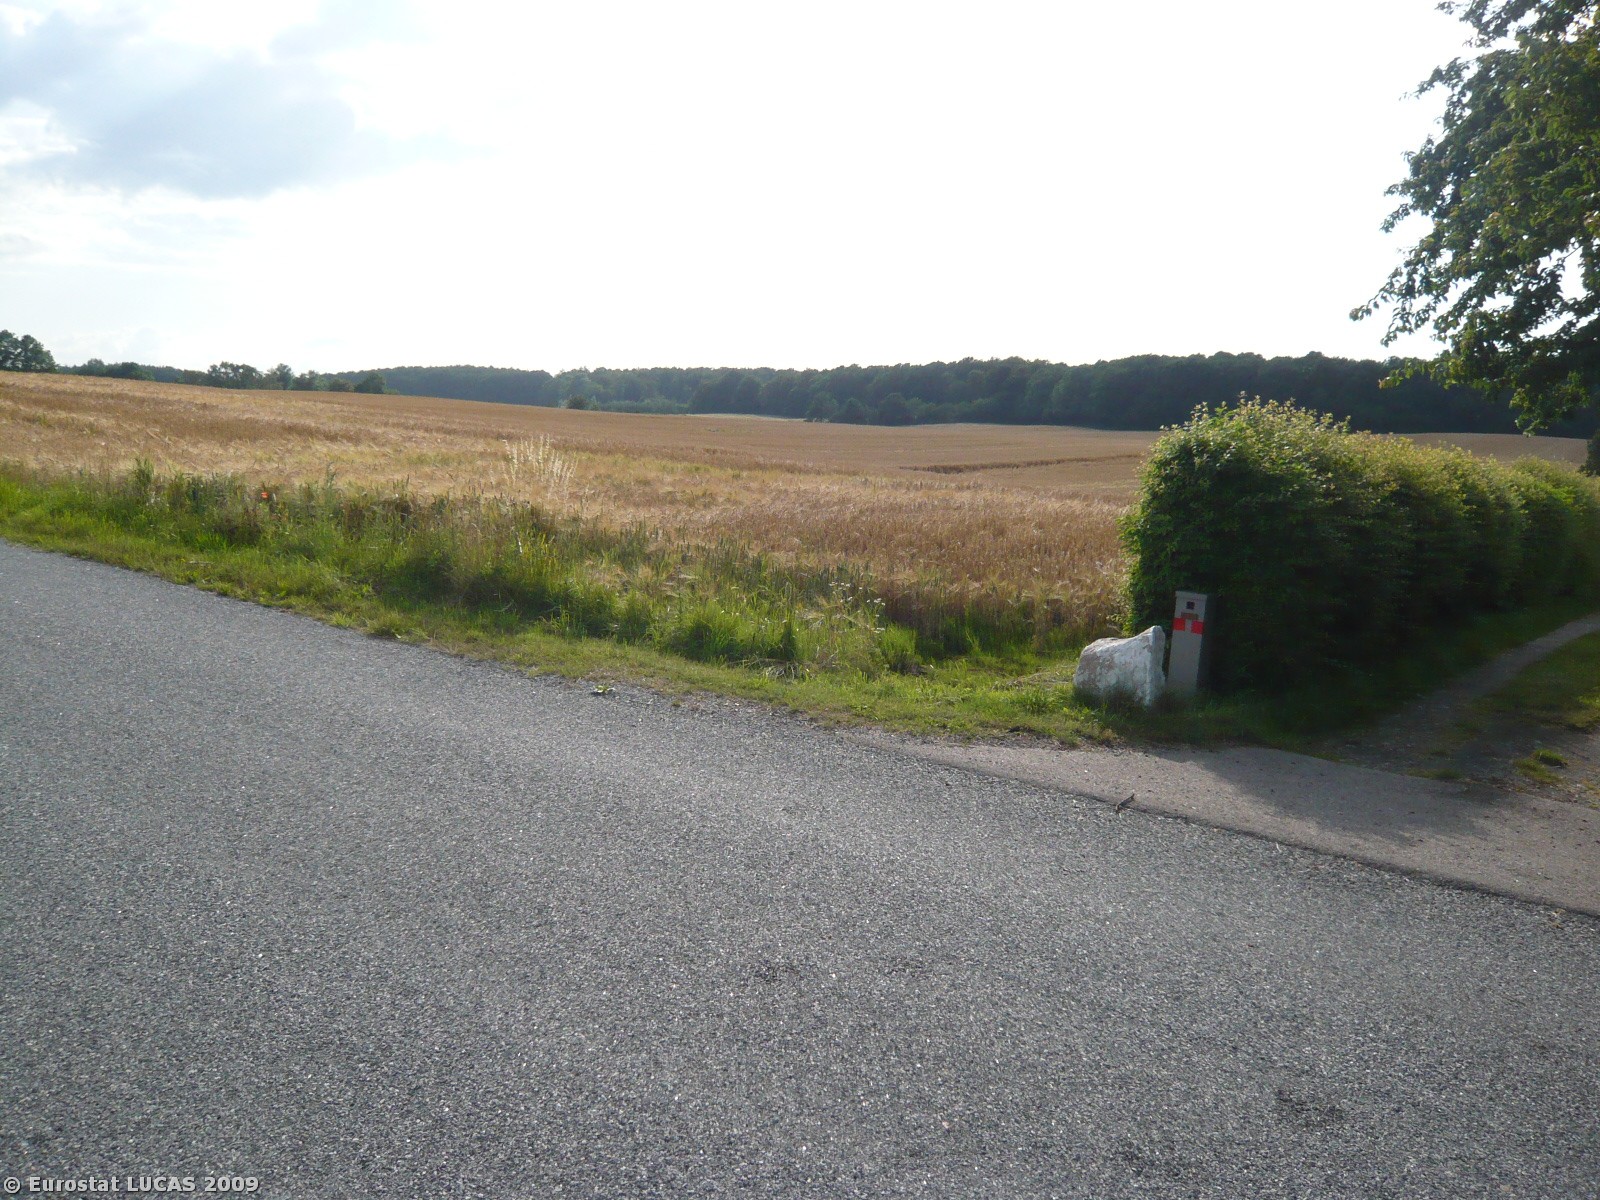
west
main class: Cropland
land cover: Common wheat
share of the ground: > 75 %
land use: Agriculture (excluding fallow land and kitchen gardens)
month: July
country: DK
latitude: 55.6036
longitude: 11.5065
